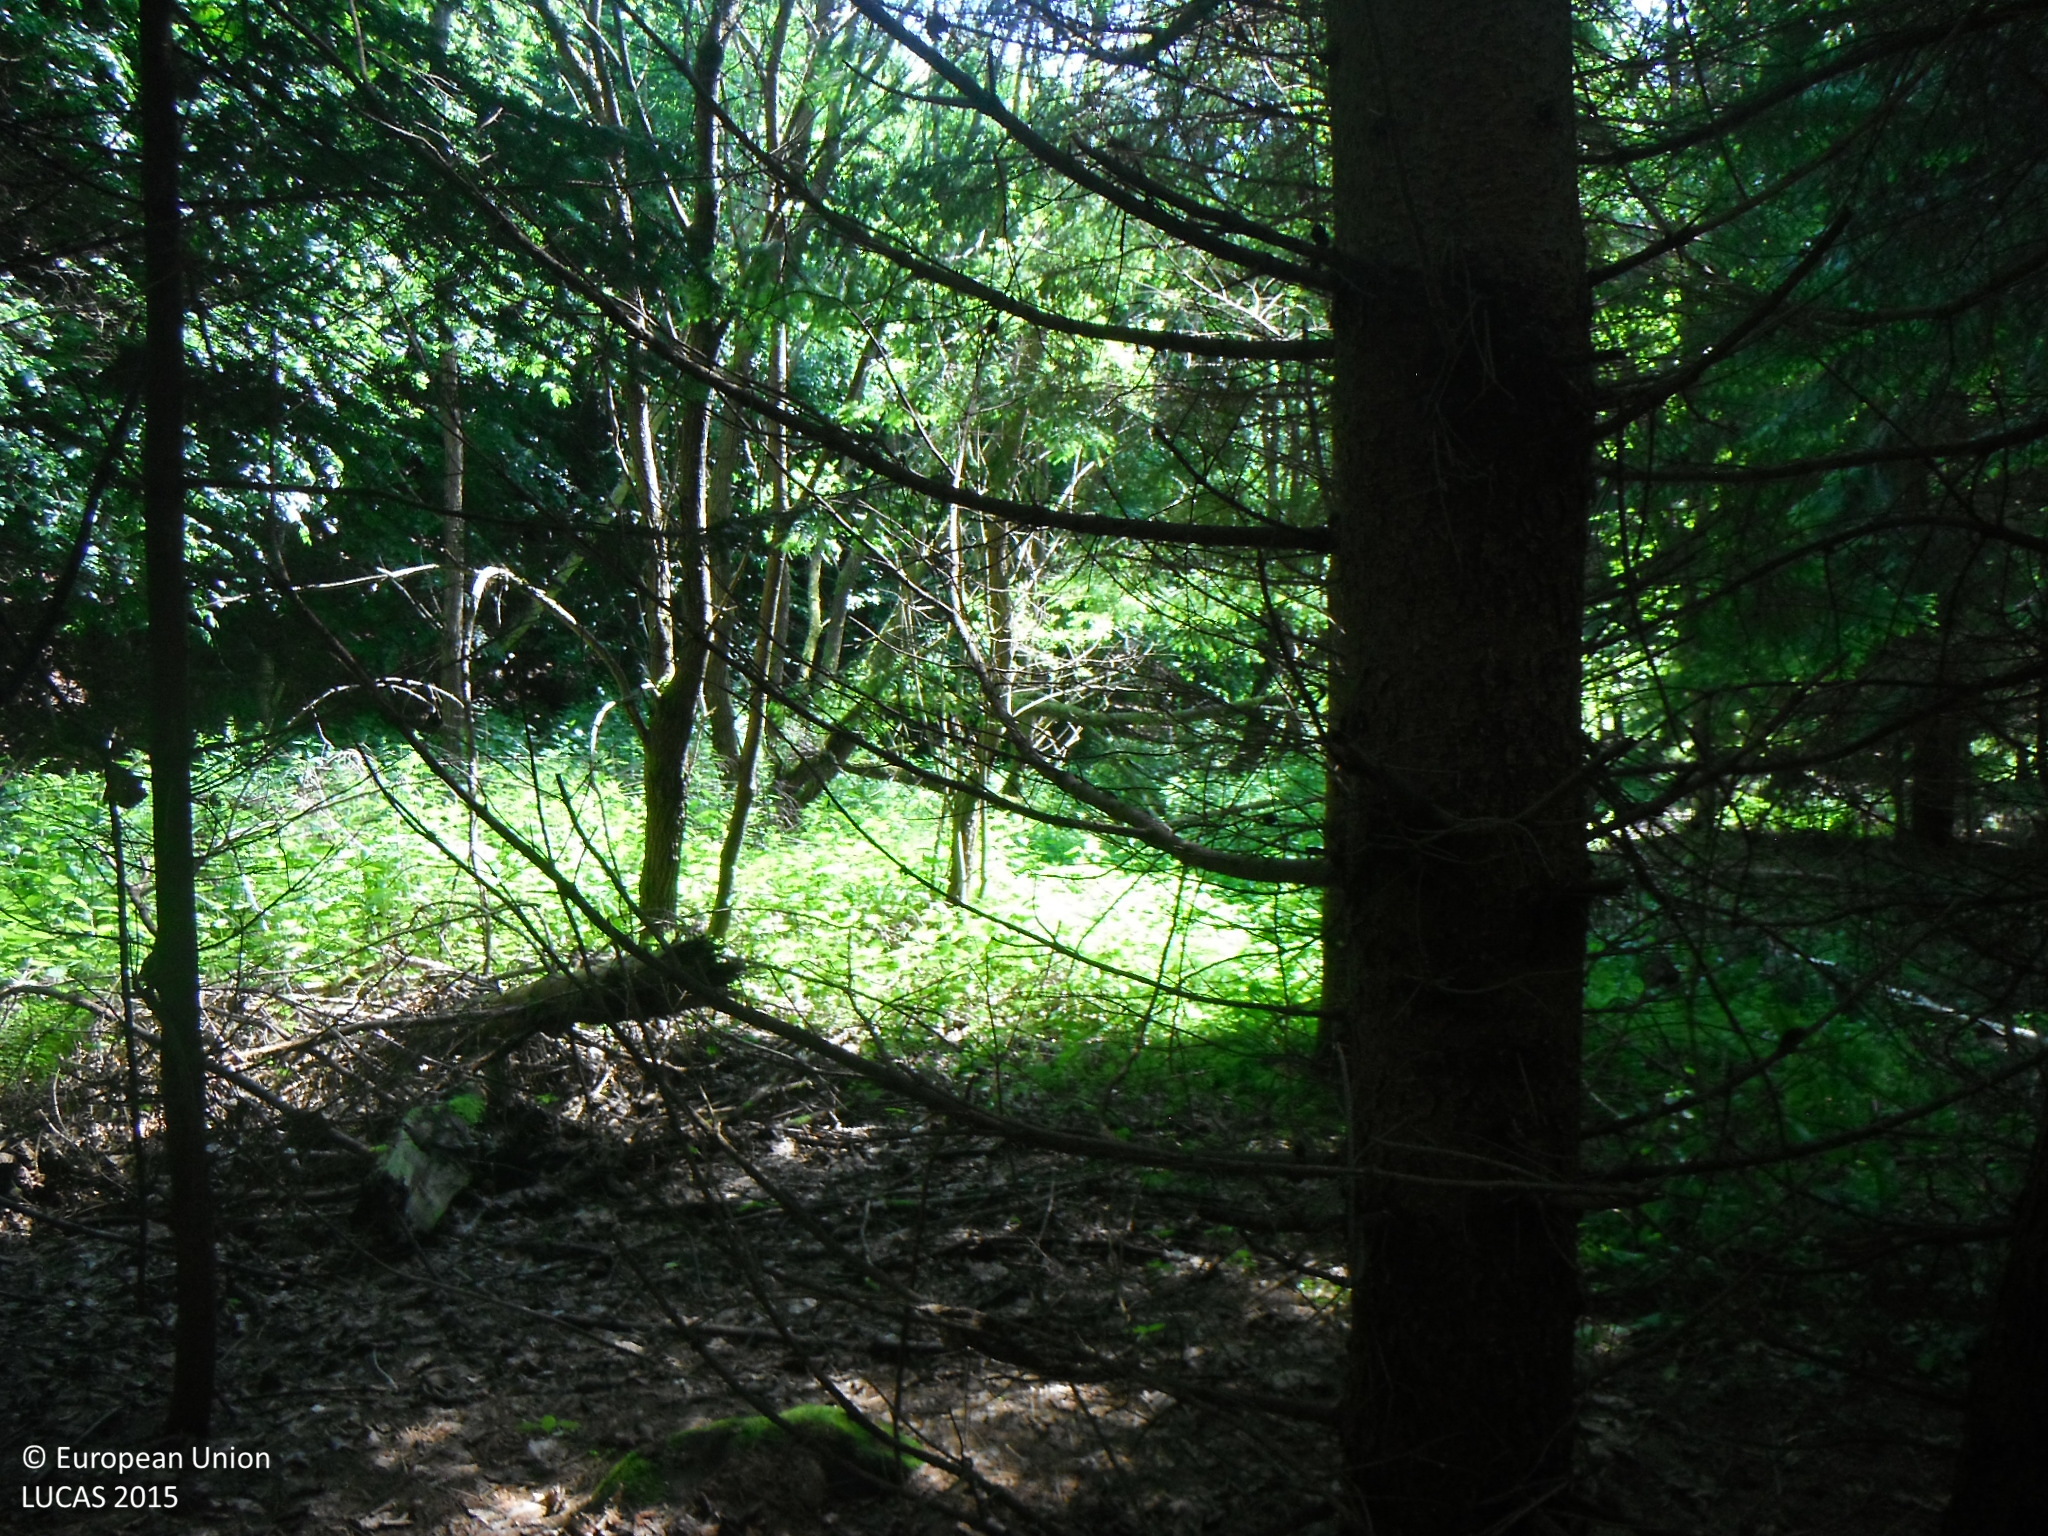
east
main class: Woodland
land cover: Spruce dominated coniferous woodland
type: alpine coniferous forest
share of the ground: > 75 %
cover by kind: coniferous forest trees 95 %, herbaceous plants 5 %
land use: Forestry
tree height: > 5 m
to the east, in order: Spruce dominated coniferous woodland; Rivers and streams; Broadleaved woodland; Tracks; Broadleaved woodland
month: June
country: SK
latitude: 48.4510
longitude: 19.4481
